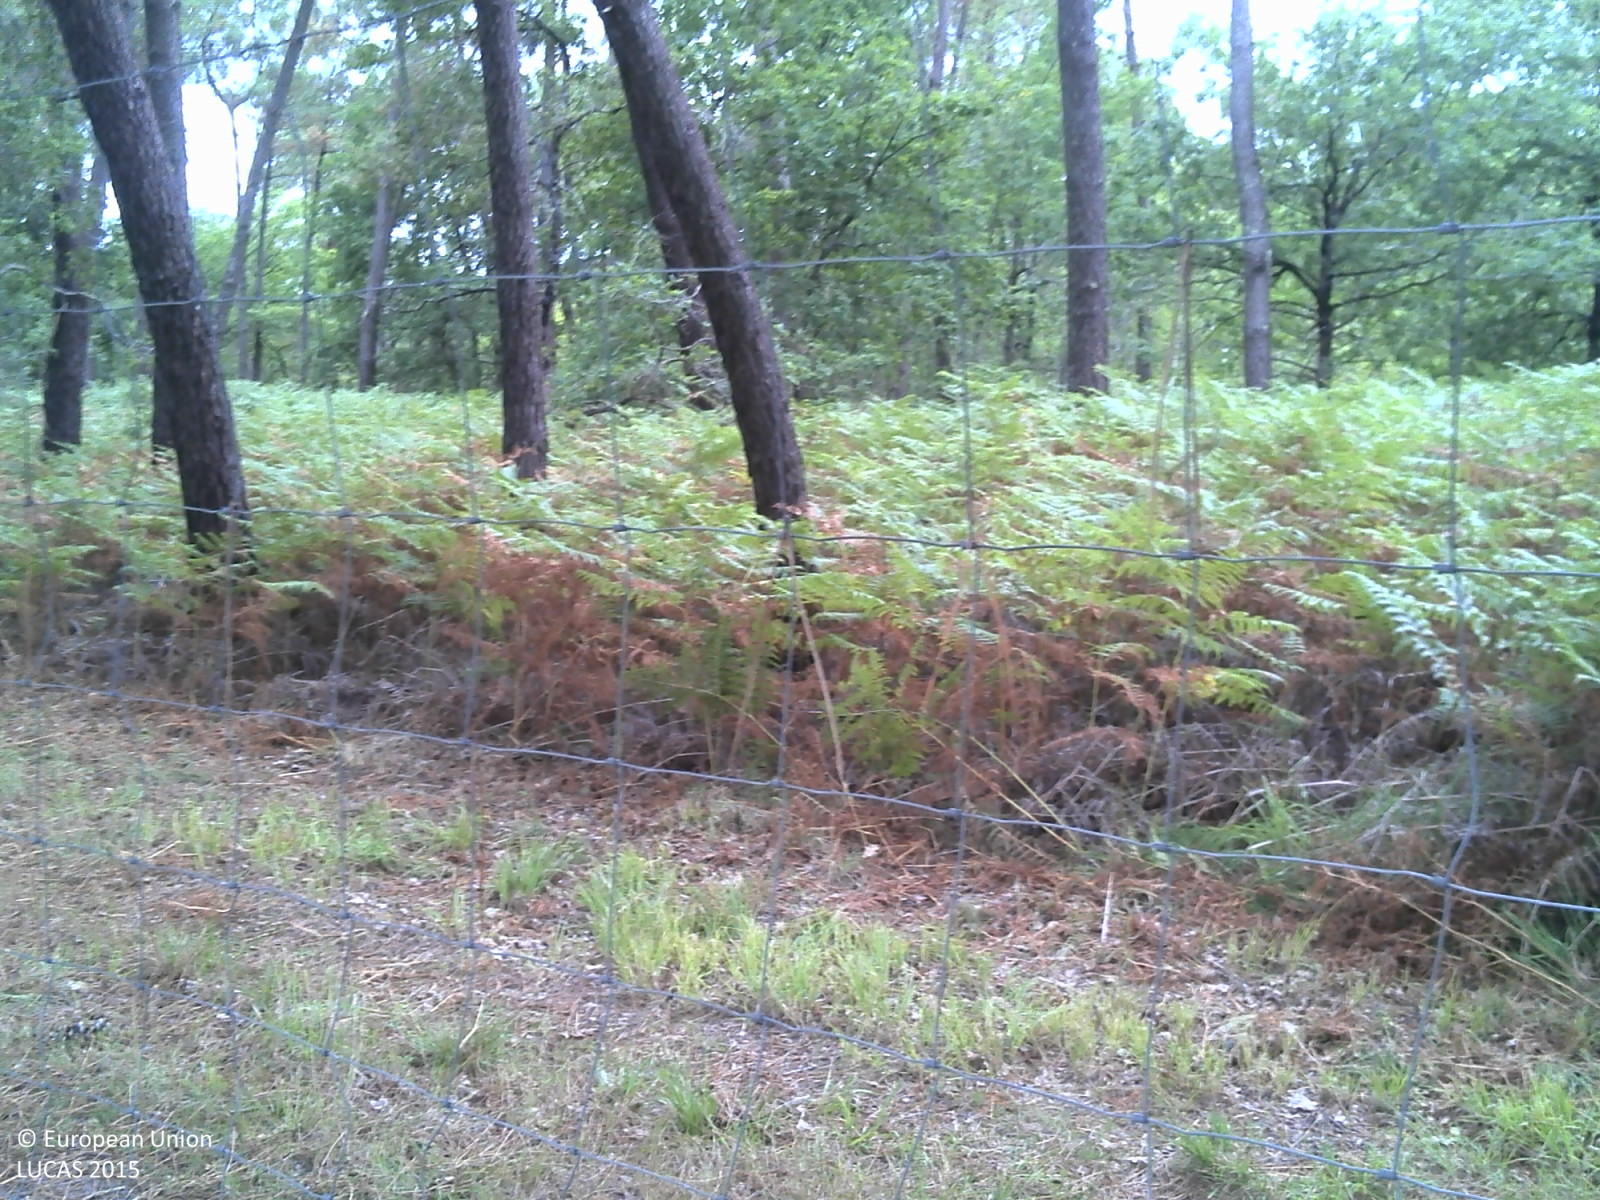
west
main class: Woodland
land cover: Pine dominated coniferous woodland
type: coniferous forest of the mediterranean region
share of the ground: > 75 %
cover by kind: coniferous forest trees 60 %, shrubs 30 %, herbaceous plants 5 %, lichens and mosses 5 %
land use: Forestry
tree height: > 5 m
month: August
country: FR
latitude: 44.7011
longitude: -0.7339
